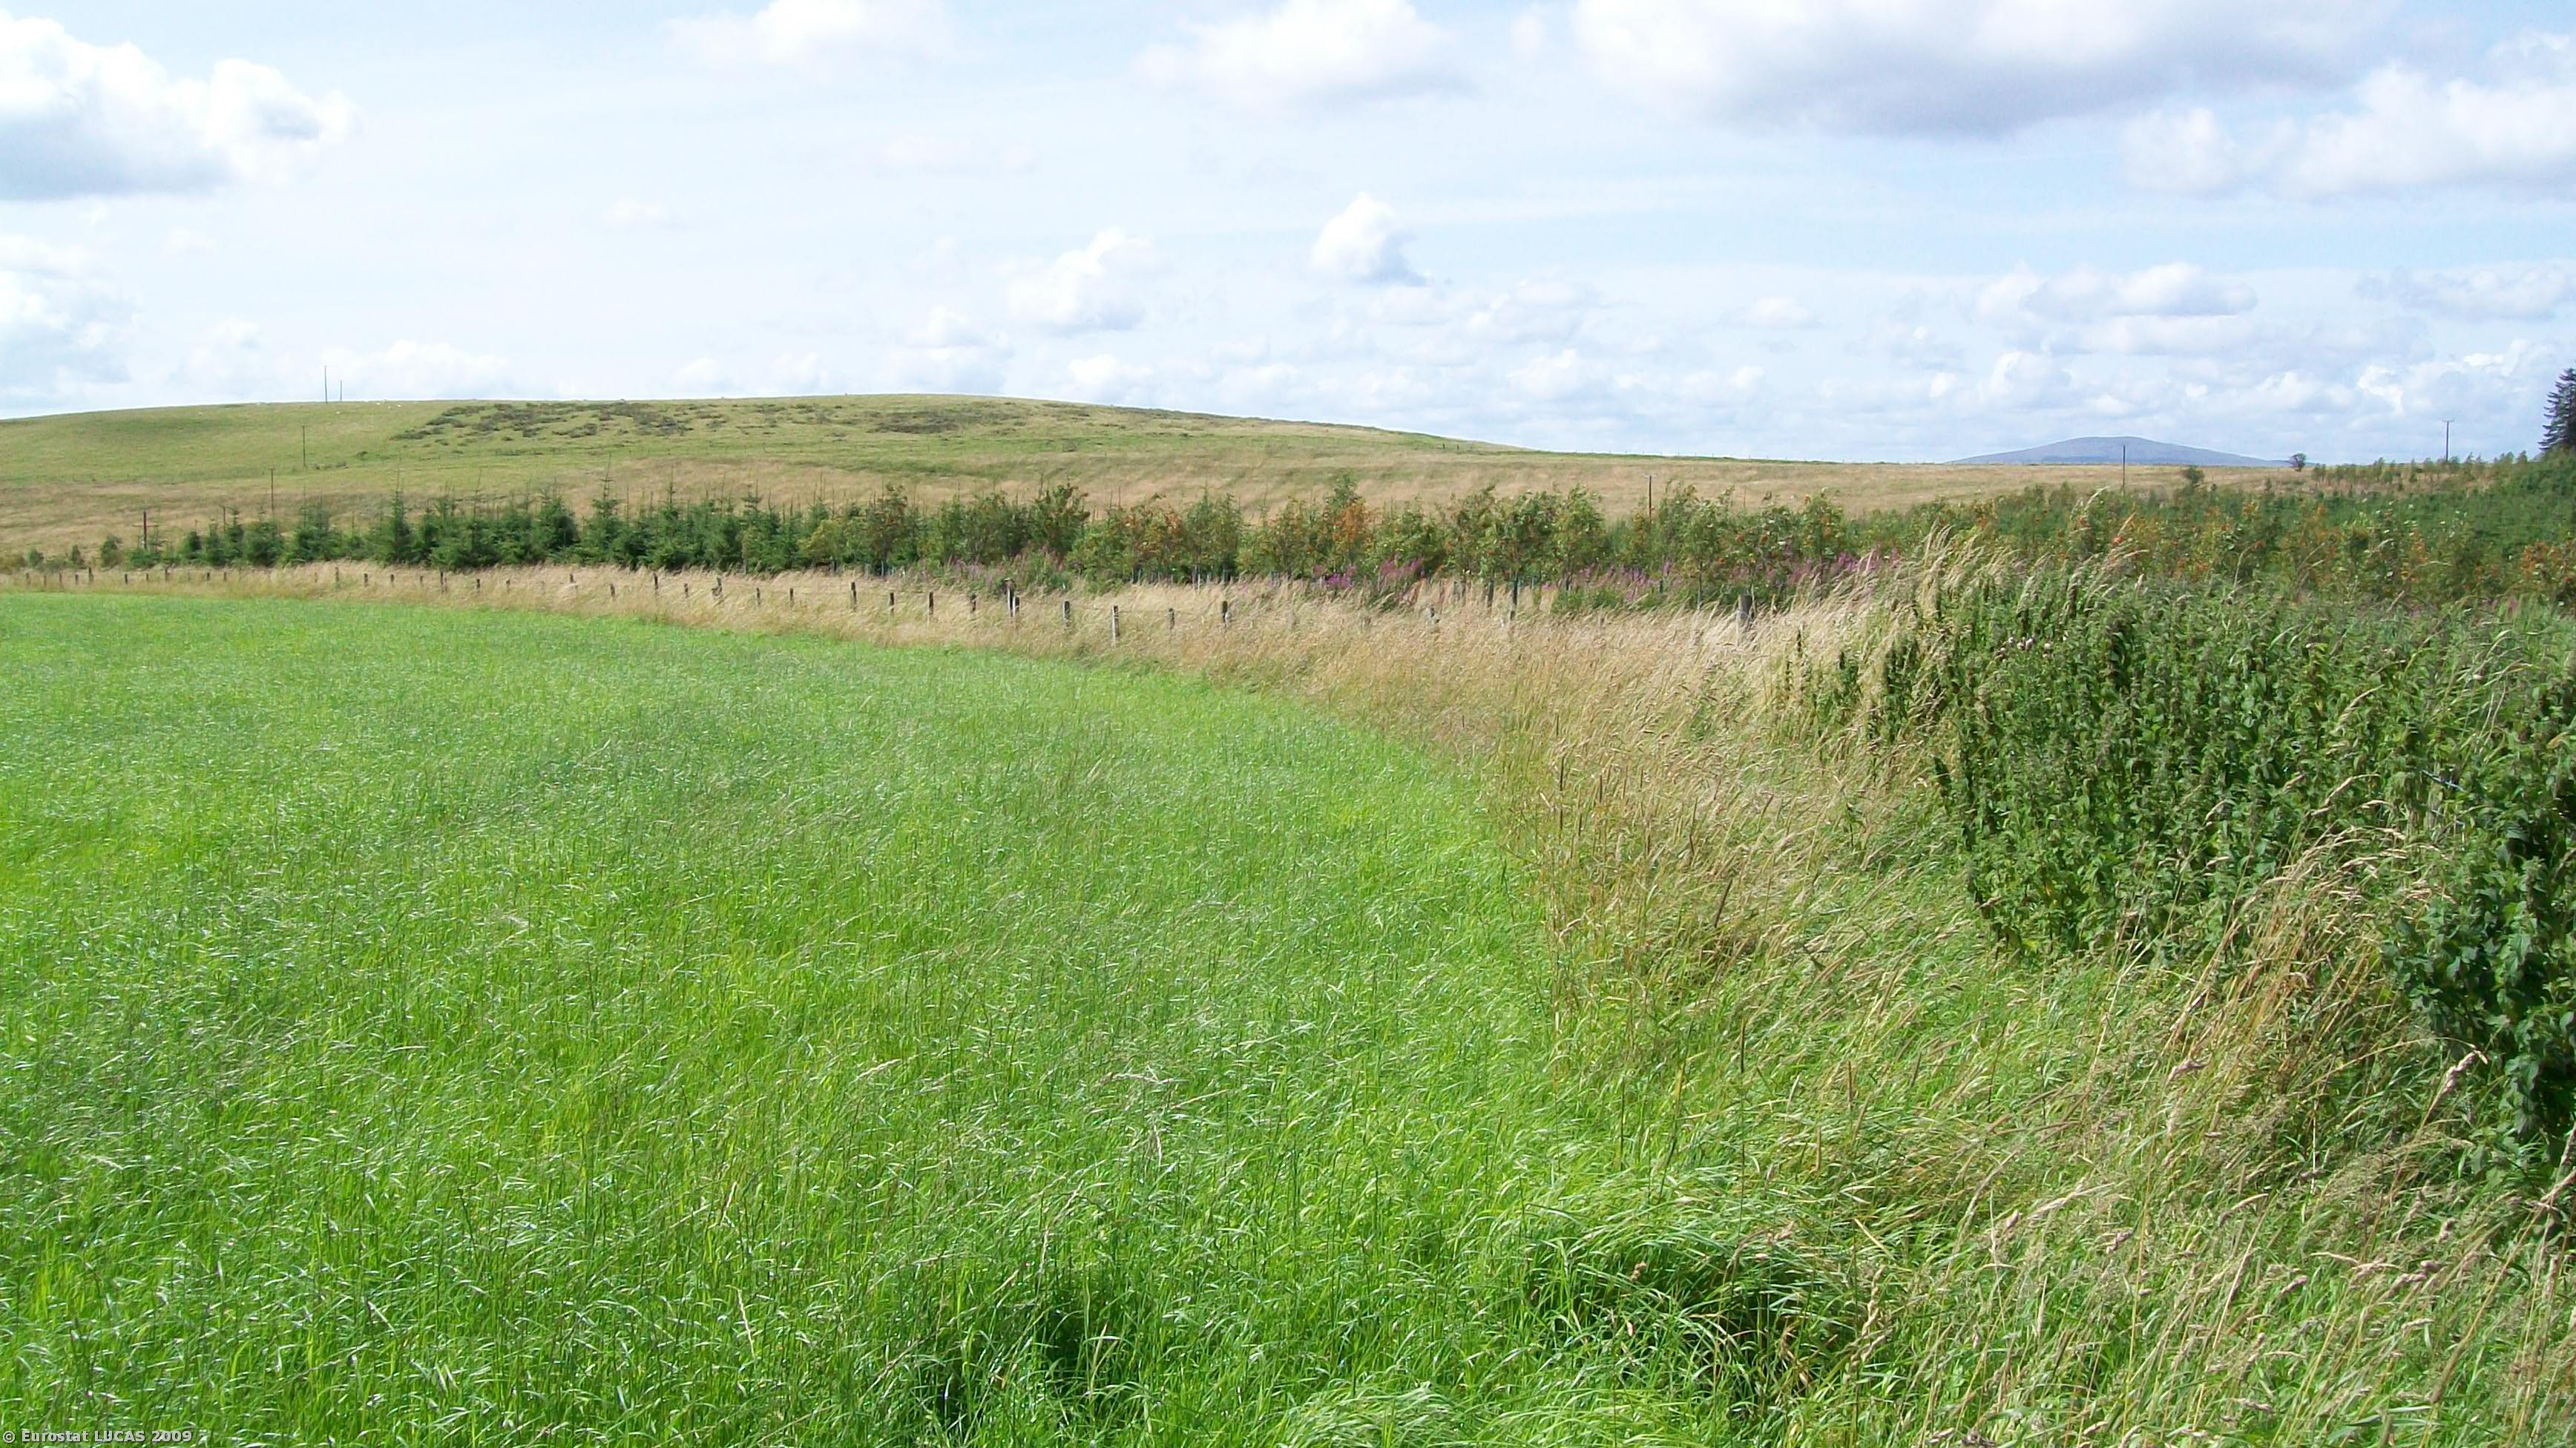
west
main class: Grassland
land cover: Grassland without tree/shrub cover
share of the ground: > 75 %
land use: Agriculture (excluding fallow land and kitchen gardens)
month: August
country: GB
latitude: 55.2291
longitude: -3.3630
